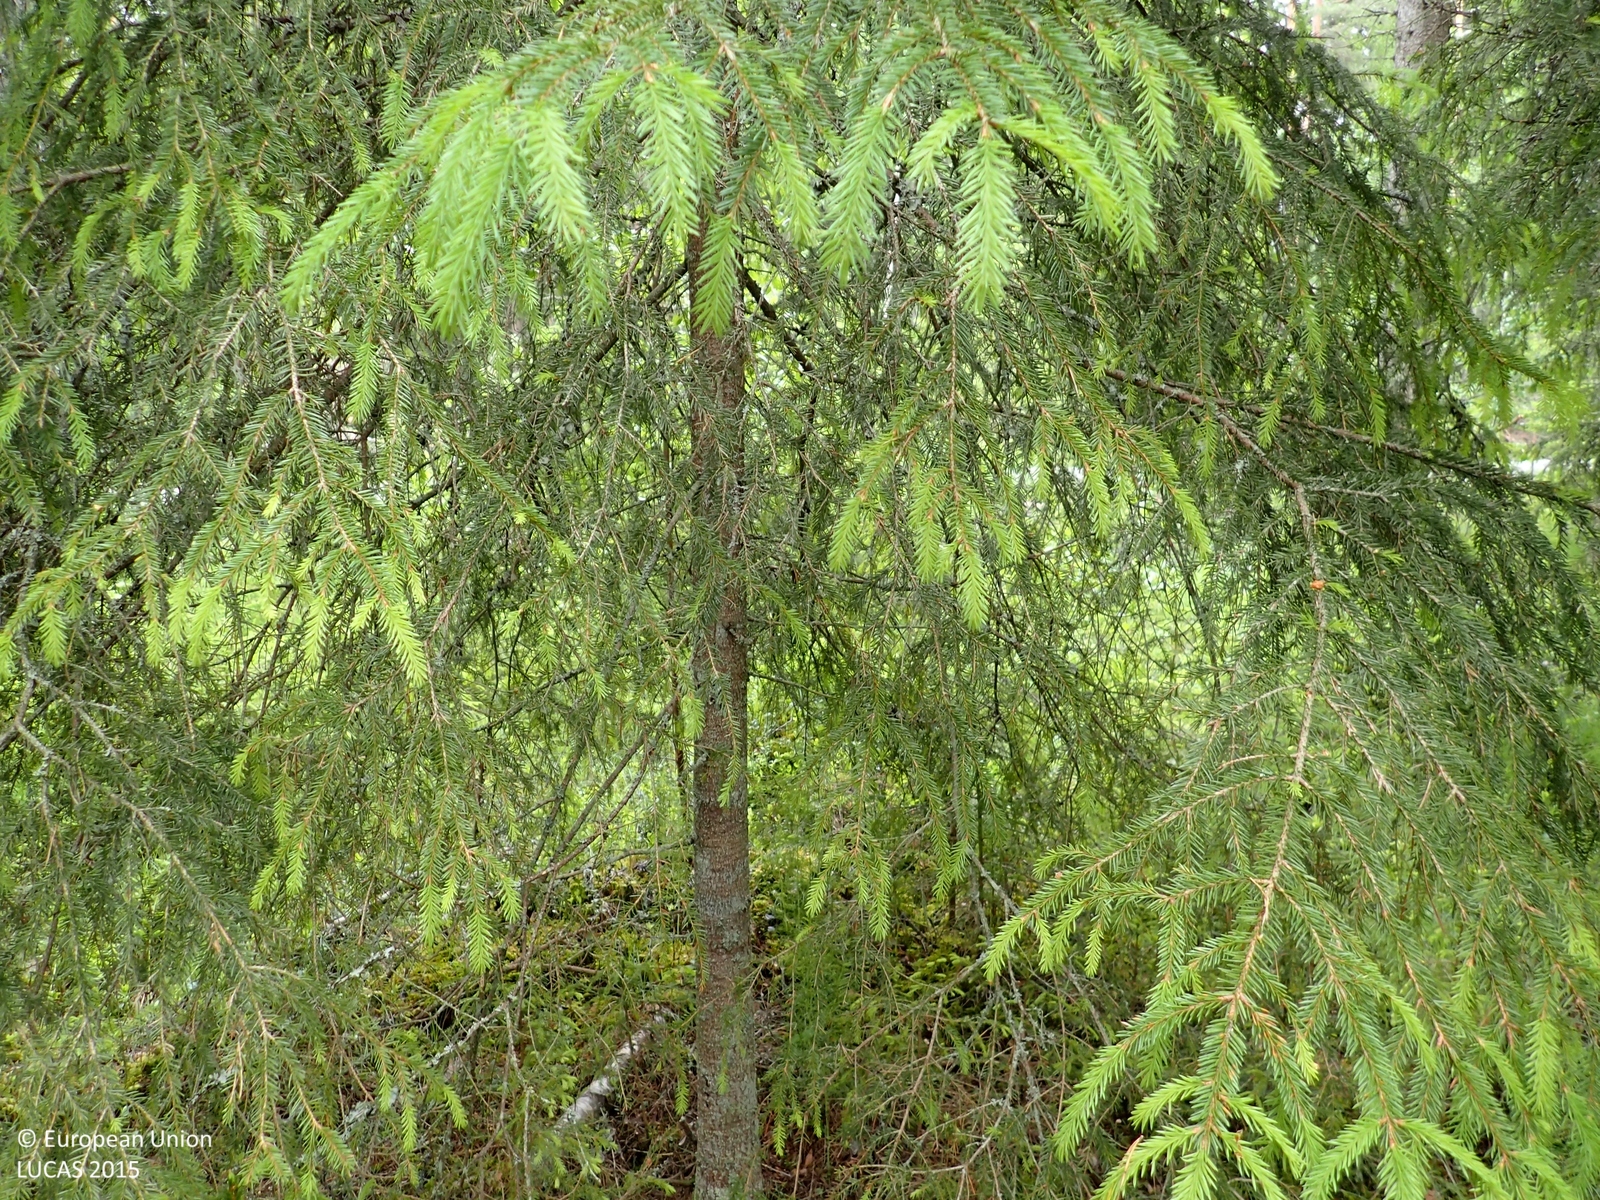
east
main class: Woodland
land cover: Other coniferous woodland
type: boreal forest
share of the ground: 50 - 75 %
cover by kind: coniferous forest trees 65 %, shrubs 15 %, herbaceous plants 15 %, broadleaved forest trees 5 %
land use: Forestry
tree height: > 5 m
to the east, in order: Other coniferous woodland; Shruby margins; Paved roads, cycling and walking lanes; Shruby margins; Ditches and canals; Shruby margins; Spruce dominated coniferous woodland; Ditches and canals; Spruce dominated coniferous woodland; Ditches and canals; Spruce dominated coniferous woodland; Ditches and canals; Spruce dominated coniferous woodland; Pine dominated coniferous woodland; Spruce dominated mixed woodland
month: June
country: FI
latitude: 62.3588
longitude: 21.6583
